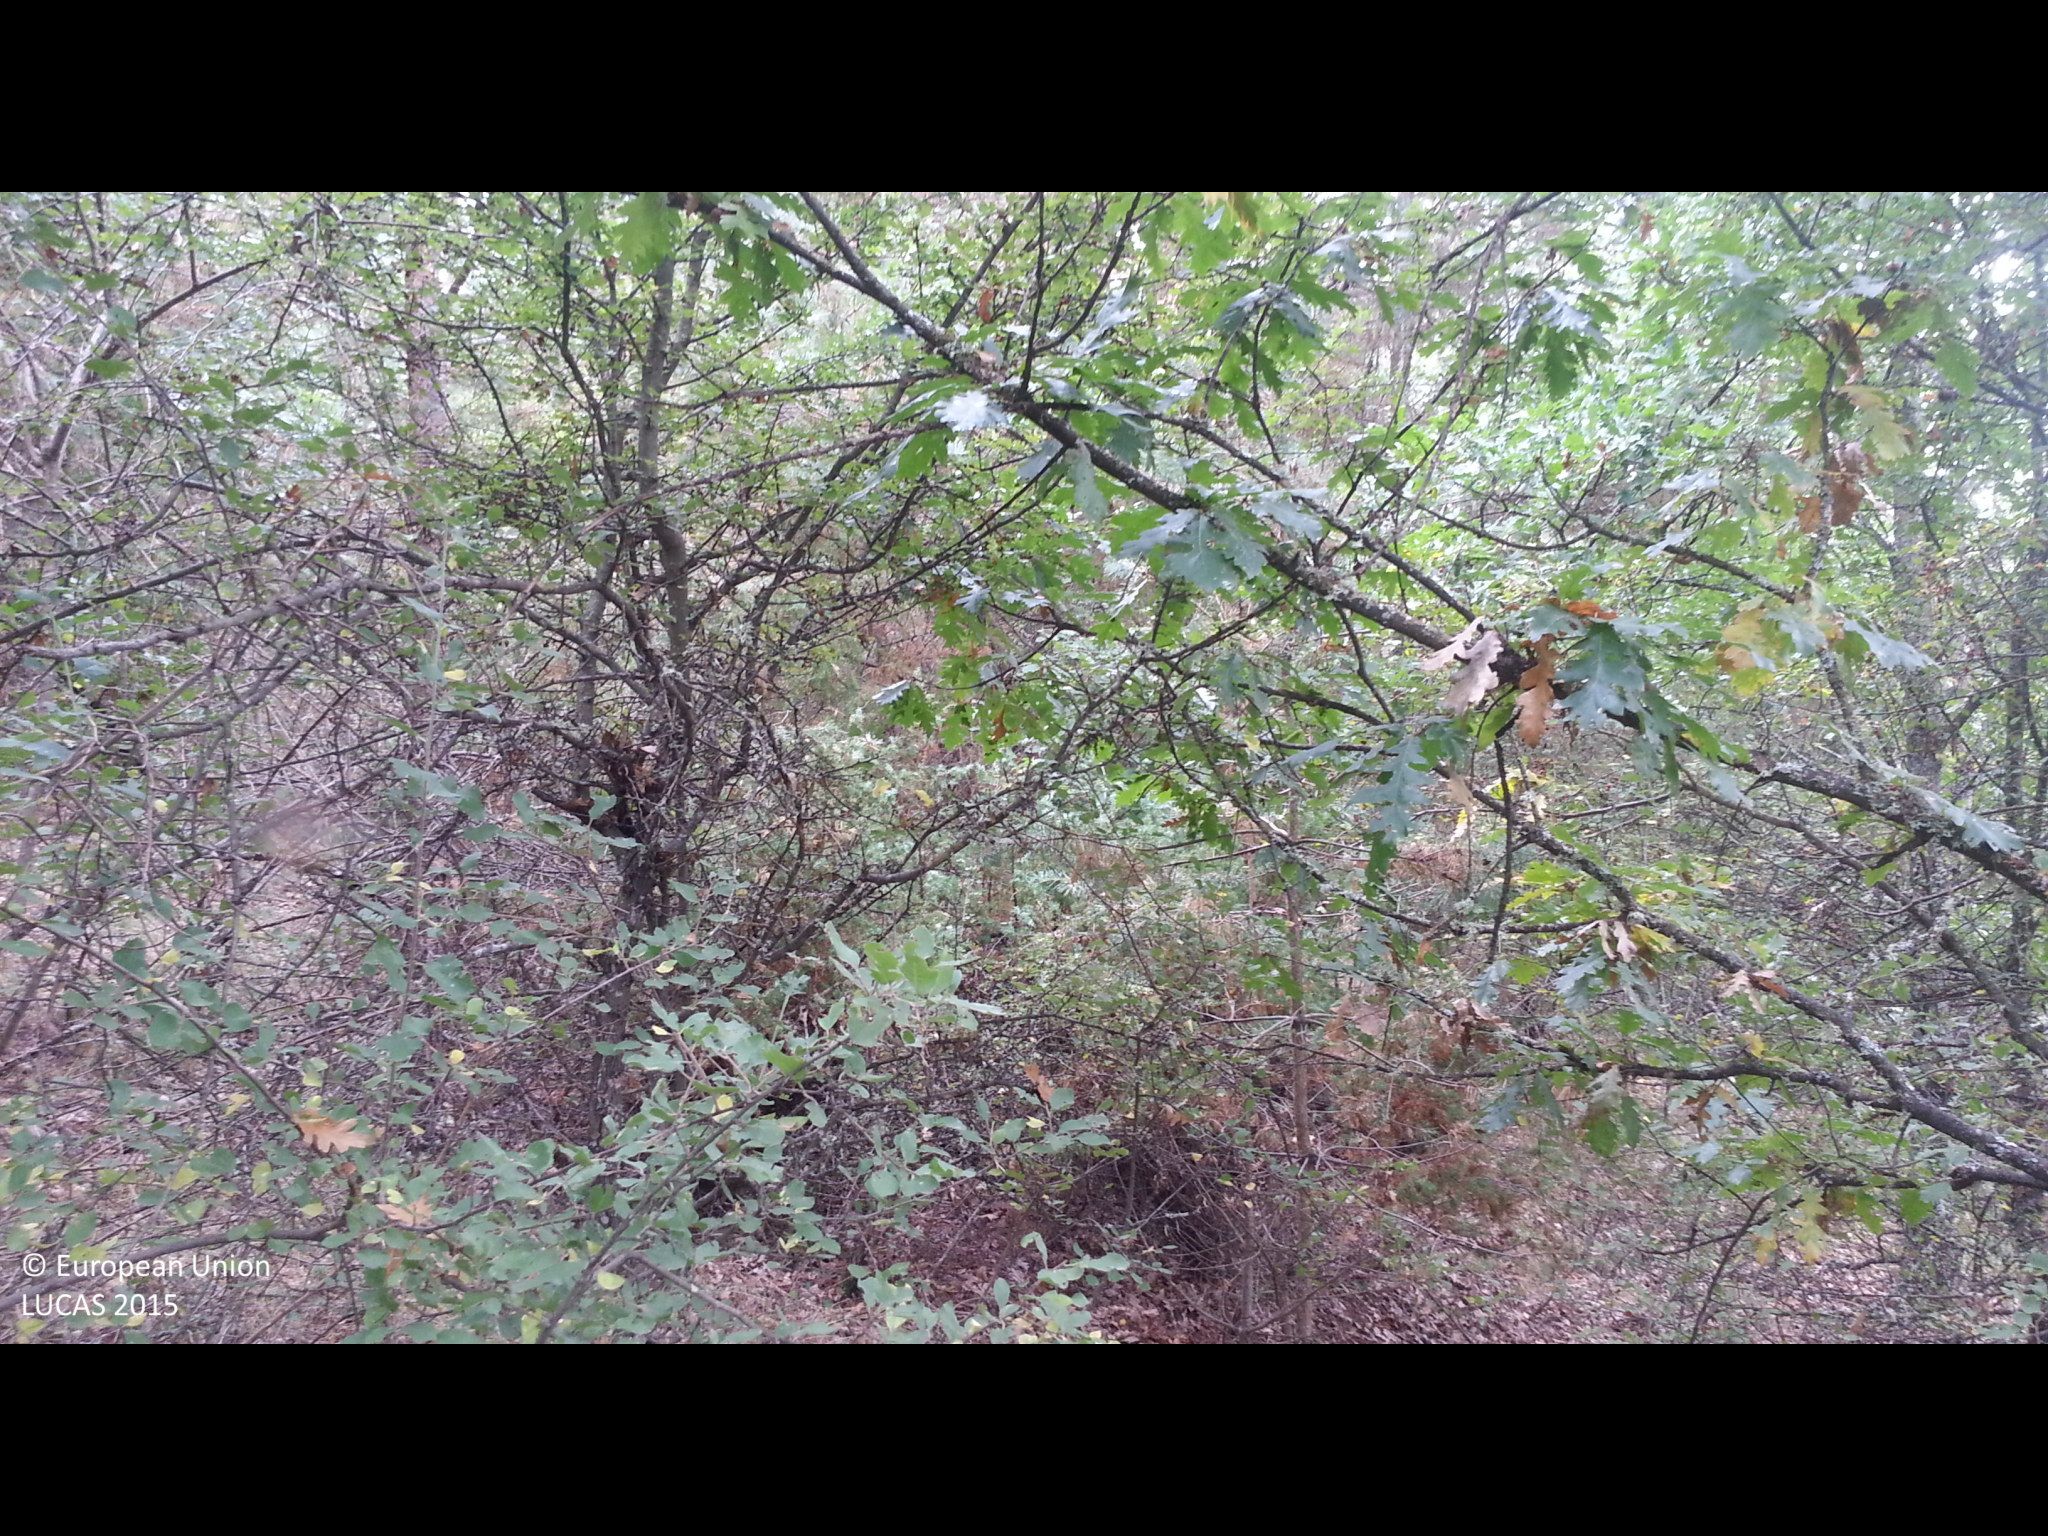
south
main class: Woodland
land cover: Broadleaved woodland
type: mesophytic deciduous forest
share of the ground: > 75 %
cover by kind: broadleaved forest trees 85 %, shrubs 10 %, coniferous forest trees 5 %
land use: Forestry
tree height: > 5 m
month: September
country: BG
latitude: 42.3760
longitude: 22.5910
